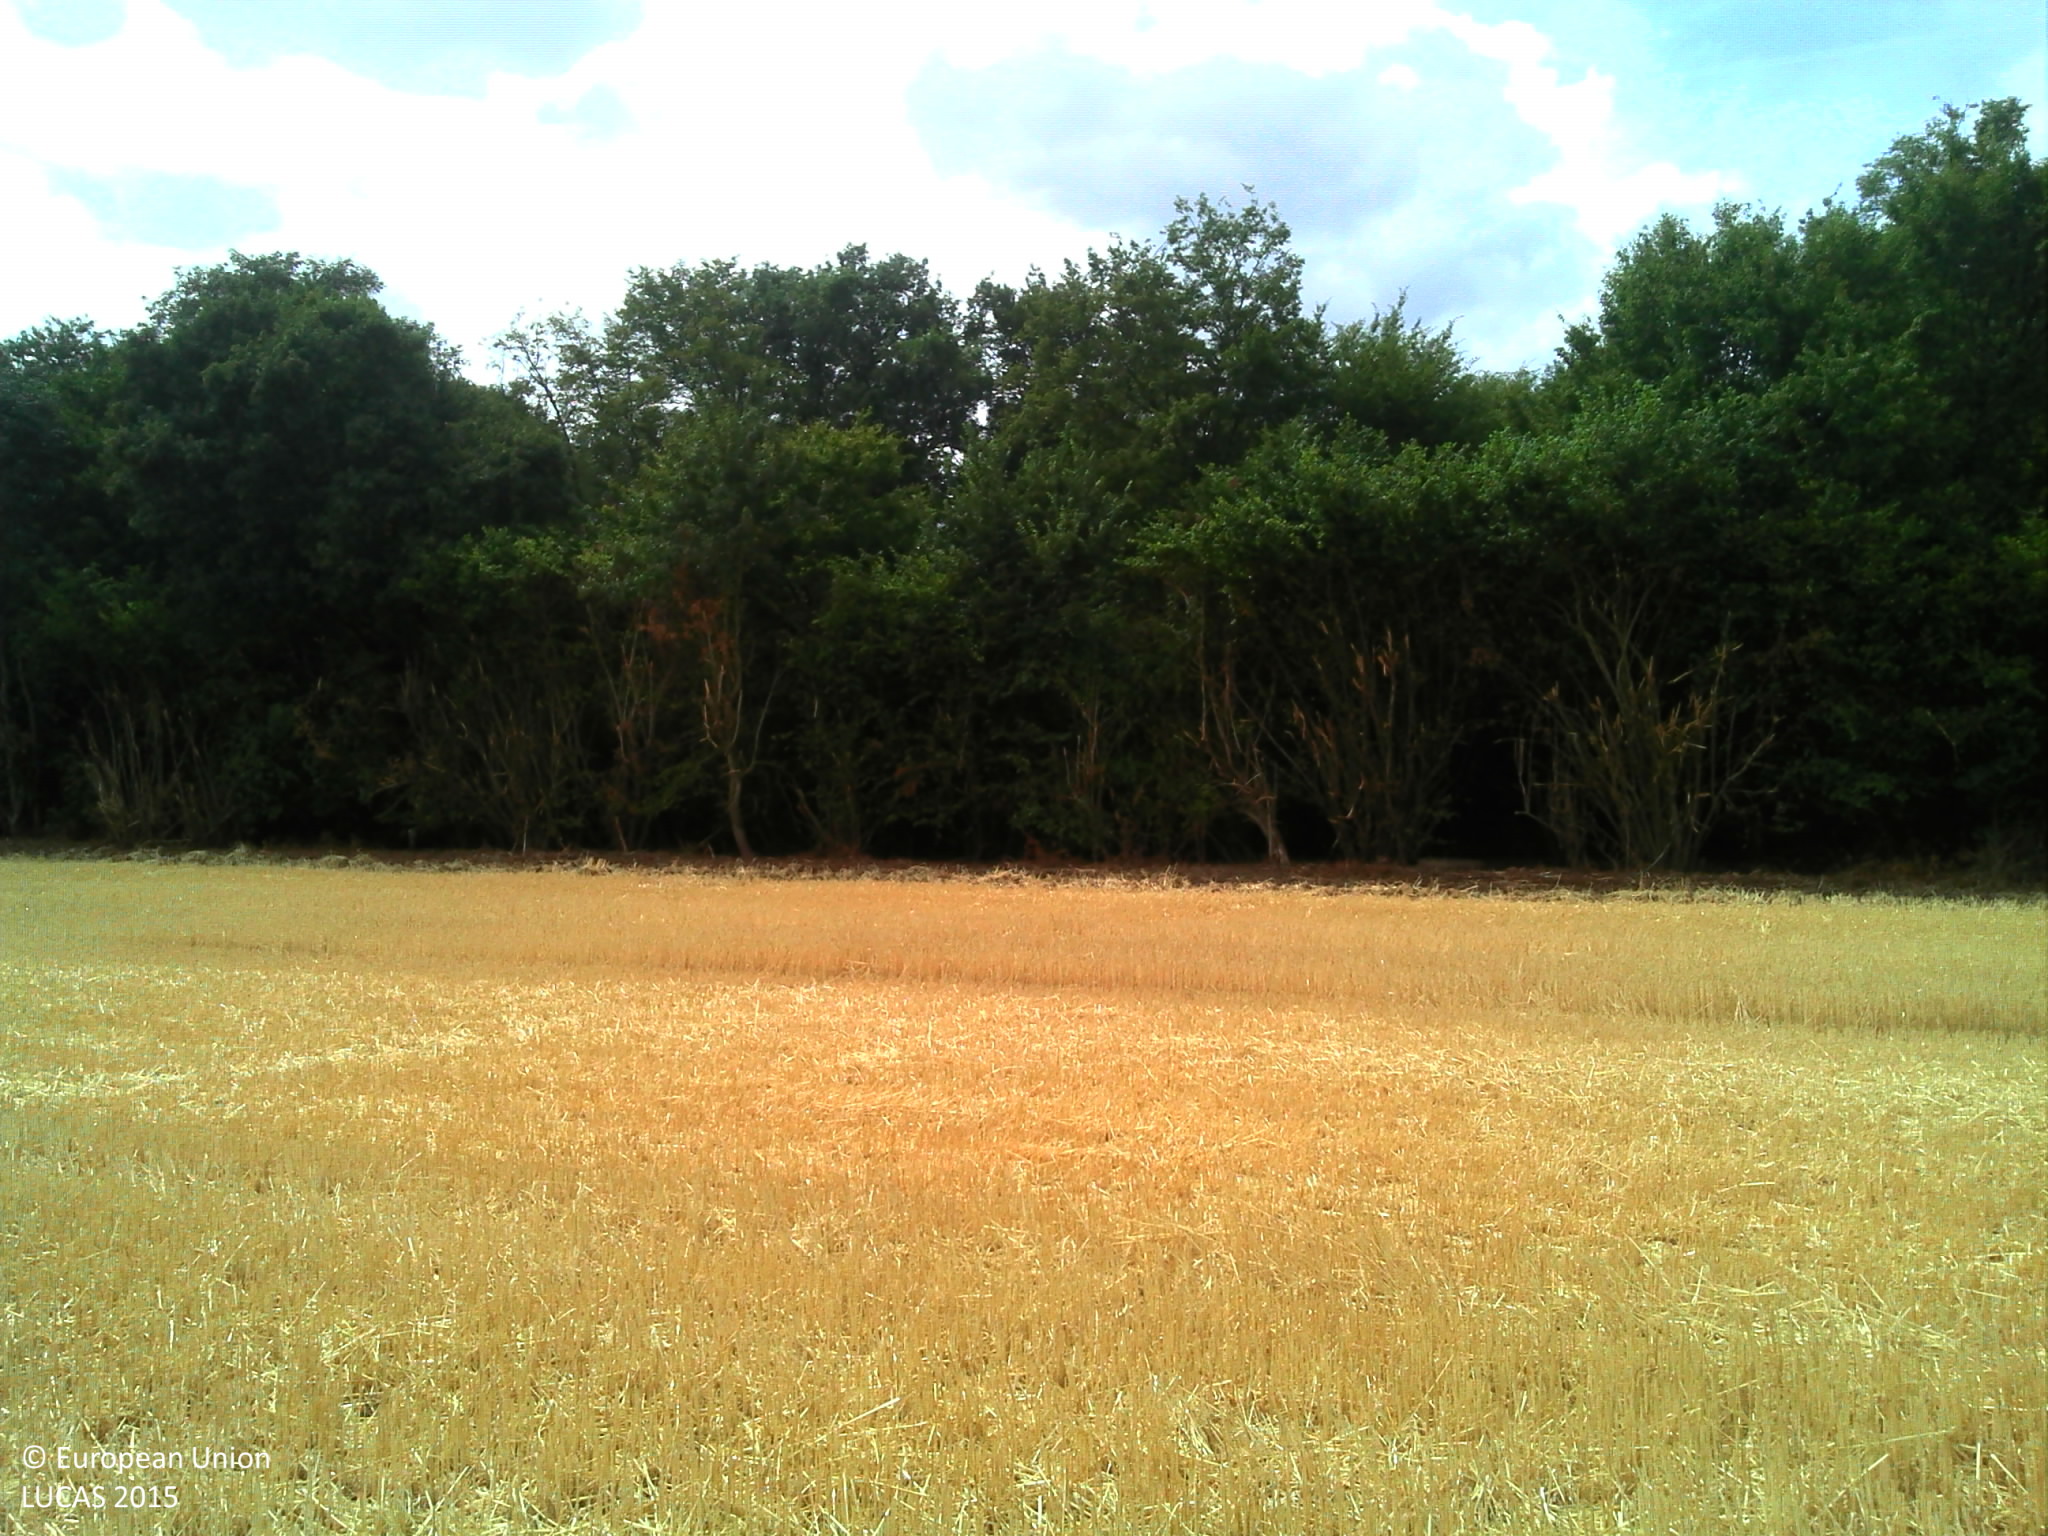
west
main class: Cropland
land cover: Common wheat
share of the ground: > 75 %
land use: Agriculture (excluding fallow land and kitchen gardens)
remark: Harvested field
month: July
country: FR
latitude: 48.5765
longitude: 2.6845
